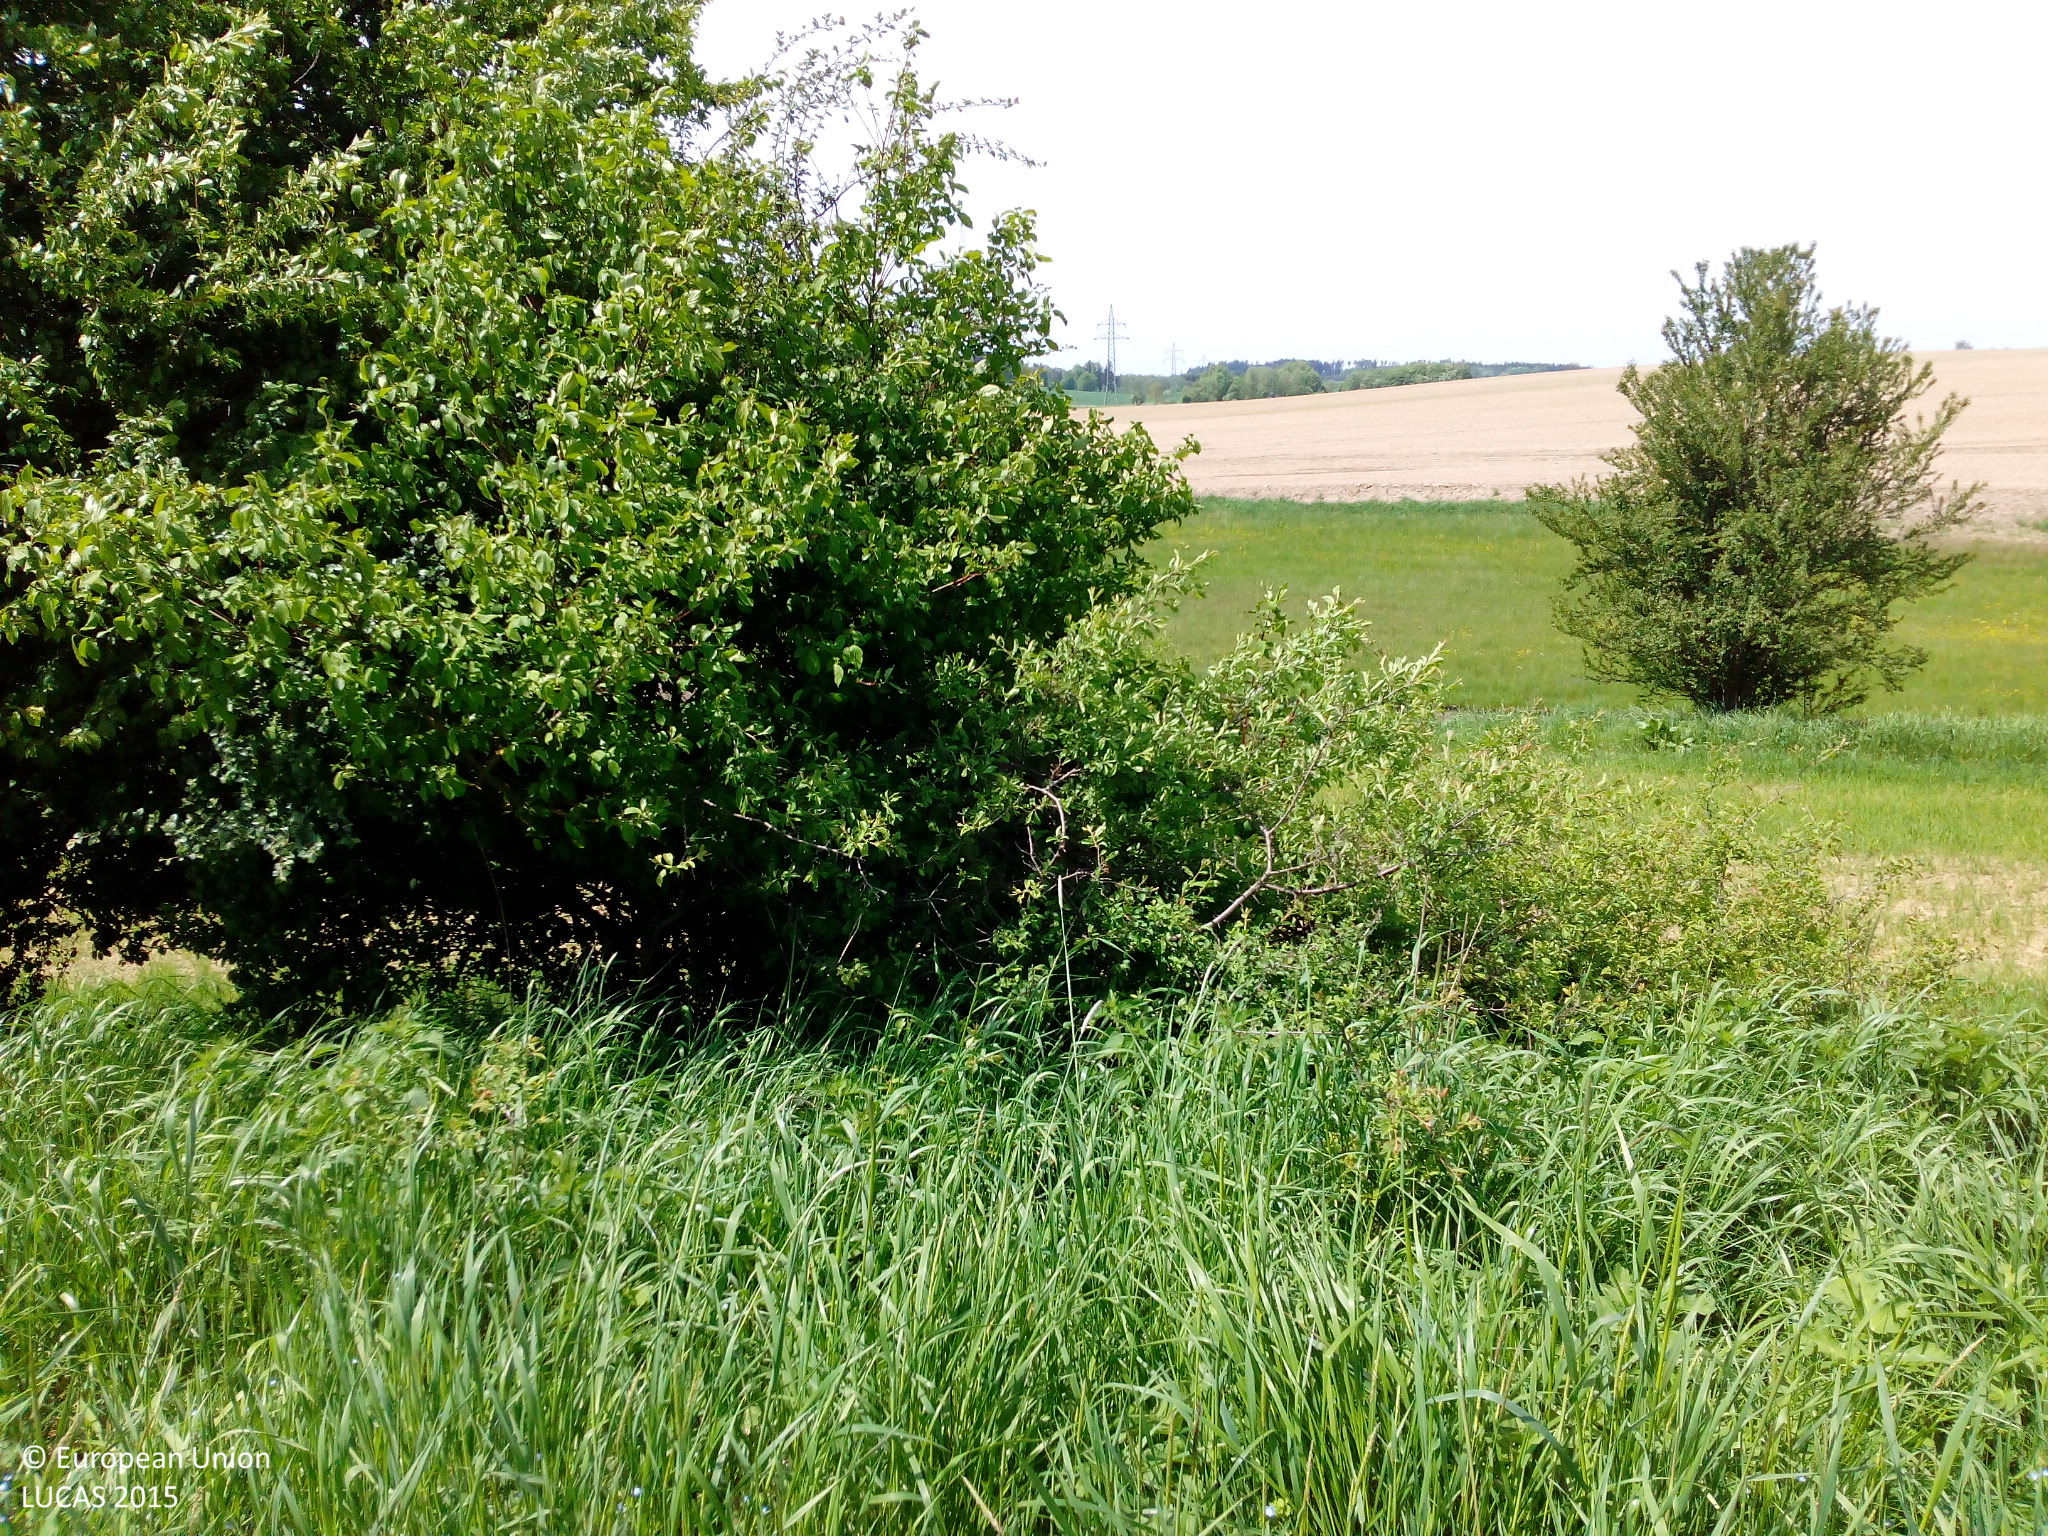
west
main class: Cropland
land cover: Barley
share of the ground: > 75 %
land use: Agriculture (excluding fallow land and kitchen gardens)
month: May
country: DE
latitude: 48.3217
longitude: 11.4693
